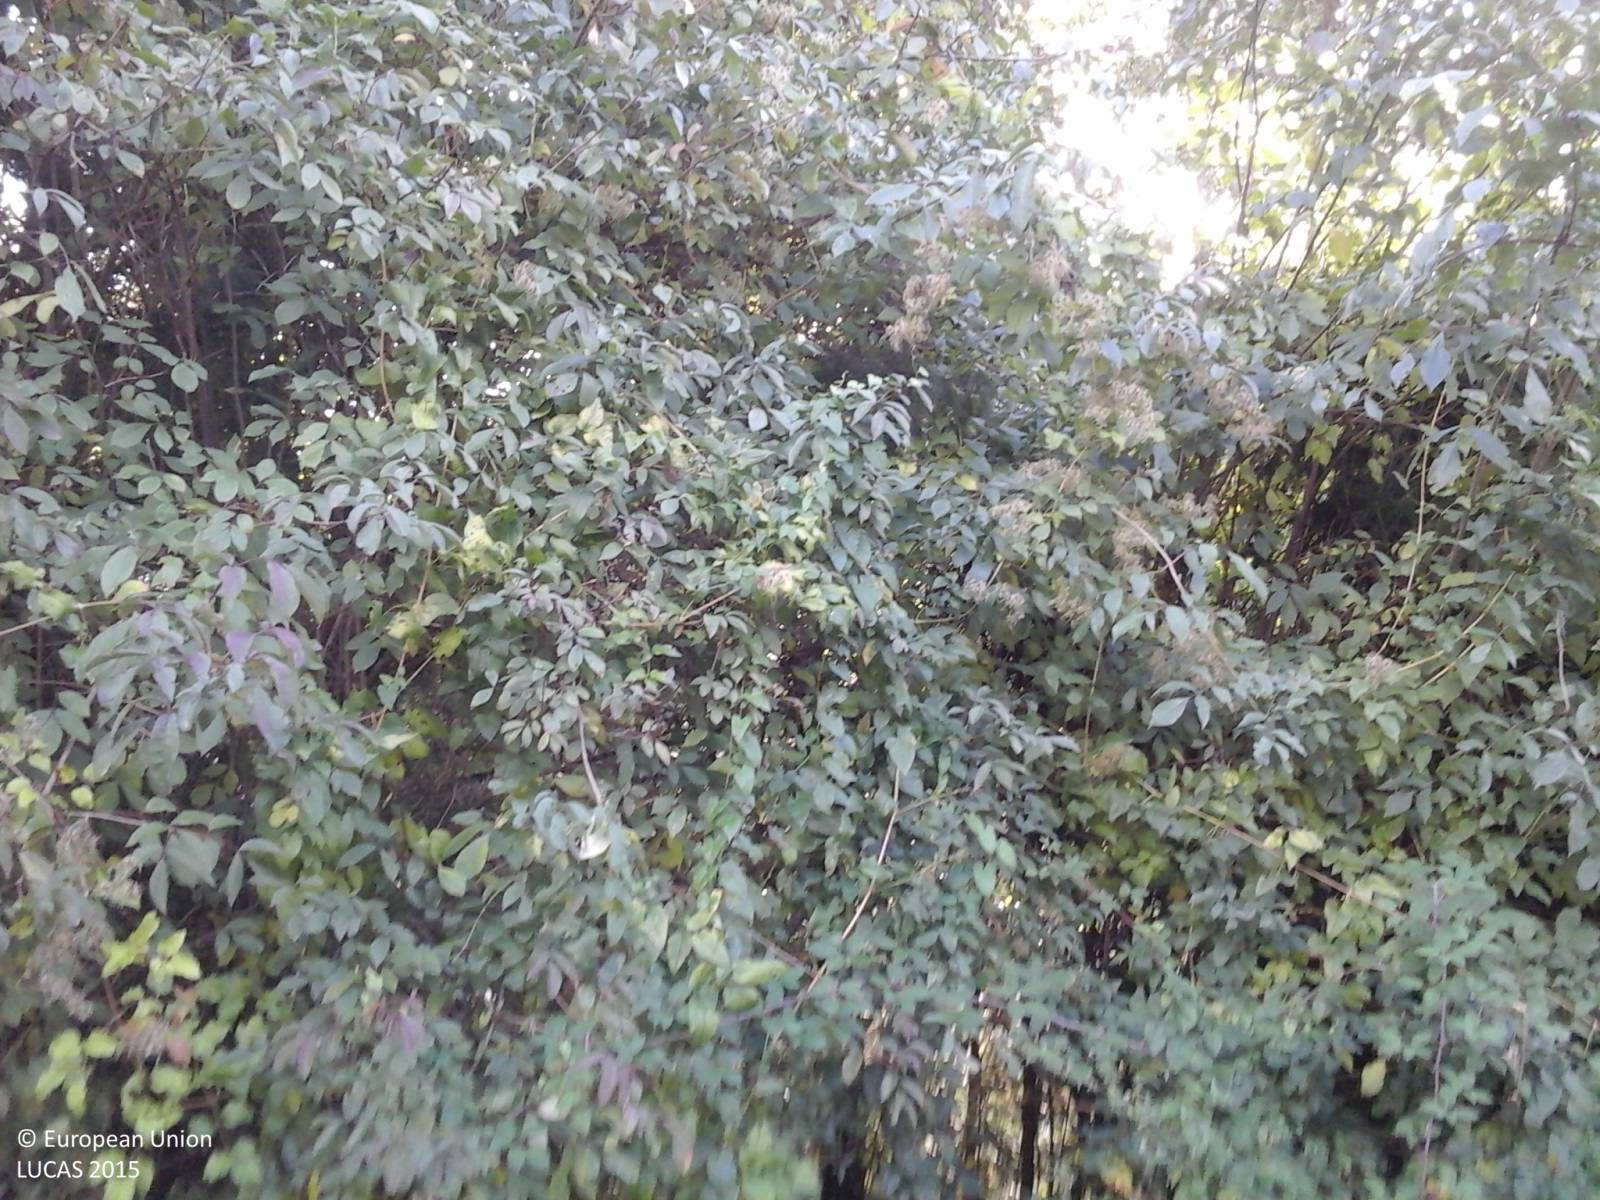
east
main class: Woodland
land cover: Other coniferous woodland
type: alpine coniferous forest
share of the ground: > 75 %
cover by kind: coniferous forest trees 100 %
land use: Forestry
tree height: > 5 m
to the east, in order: Other coniferous woodland; Broadleaved woodland; Fences; Tracks; Broadleaved woodland; Paved roads, cycling and walking lanes
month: October
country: IT
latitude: 43.7060
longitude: 11.6462
